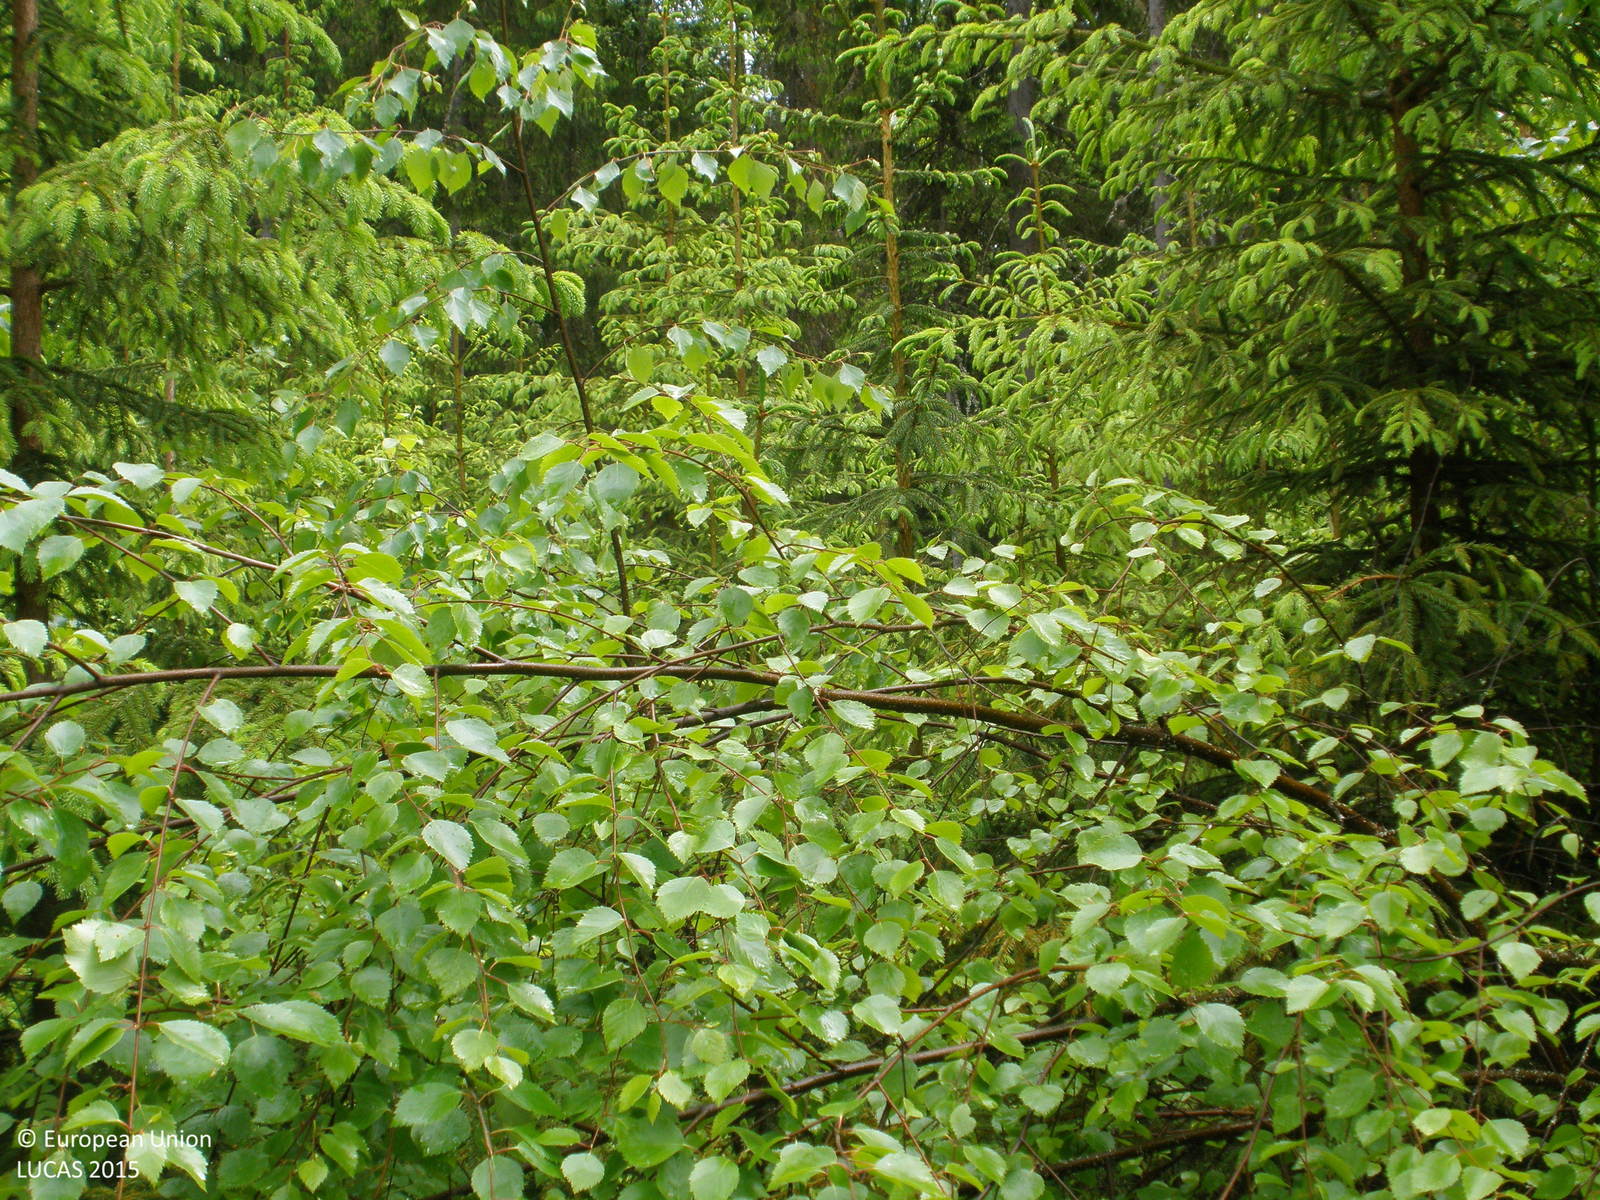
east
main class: Woodland
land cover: Spruce dominated mixed woodland
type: boreal forest
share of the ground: 50 - 75 %
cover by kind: broadleaved forest trees 40 %, coniferous forest trees 30 %, herbaceous plants 20 %, shrubs 10 %
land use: Forestry
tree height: < 5 m
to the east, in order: Spruce dominated mixed woodland; Spruce dominated coniferous woodland; Broadleaved woodland; Spruce dominated mixed woodland
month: June
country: FI
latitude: 61.1939
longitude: 24.4438
